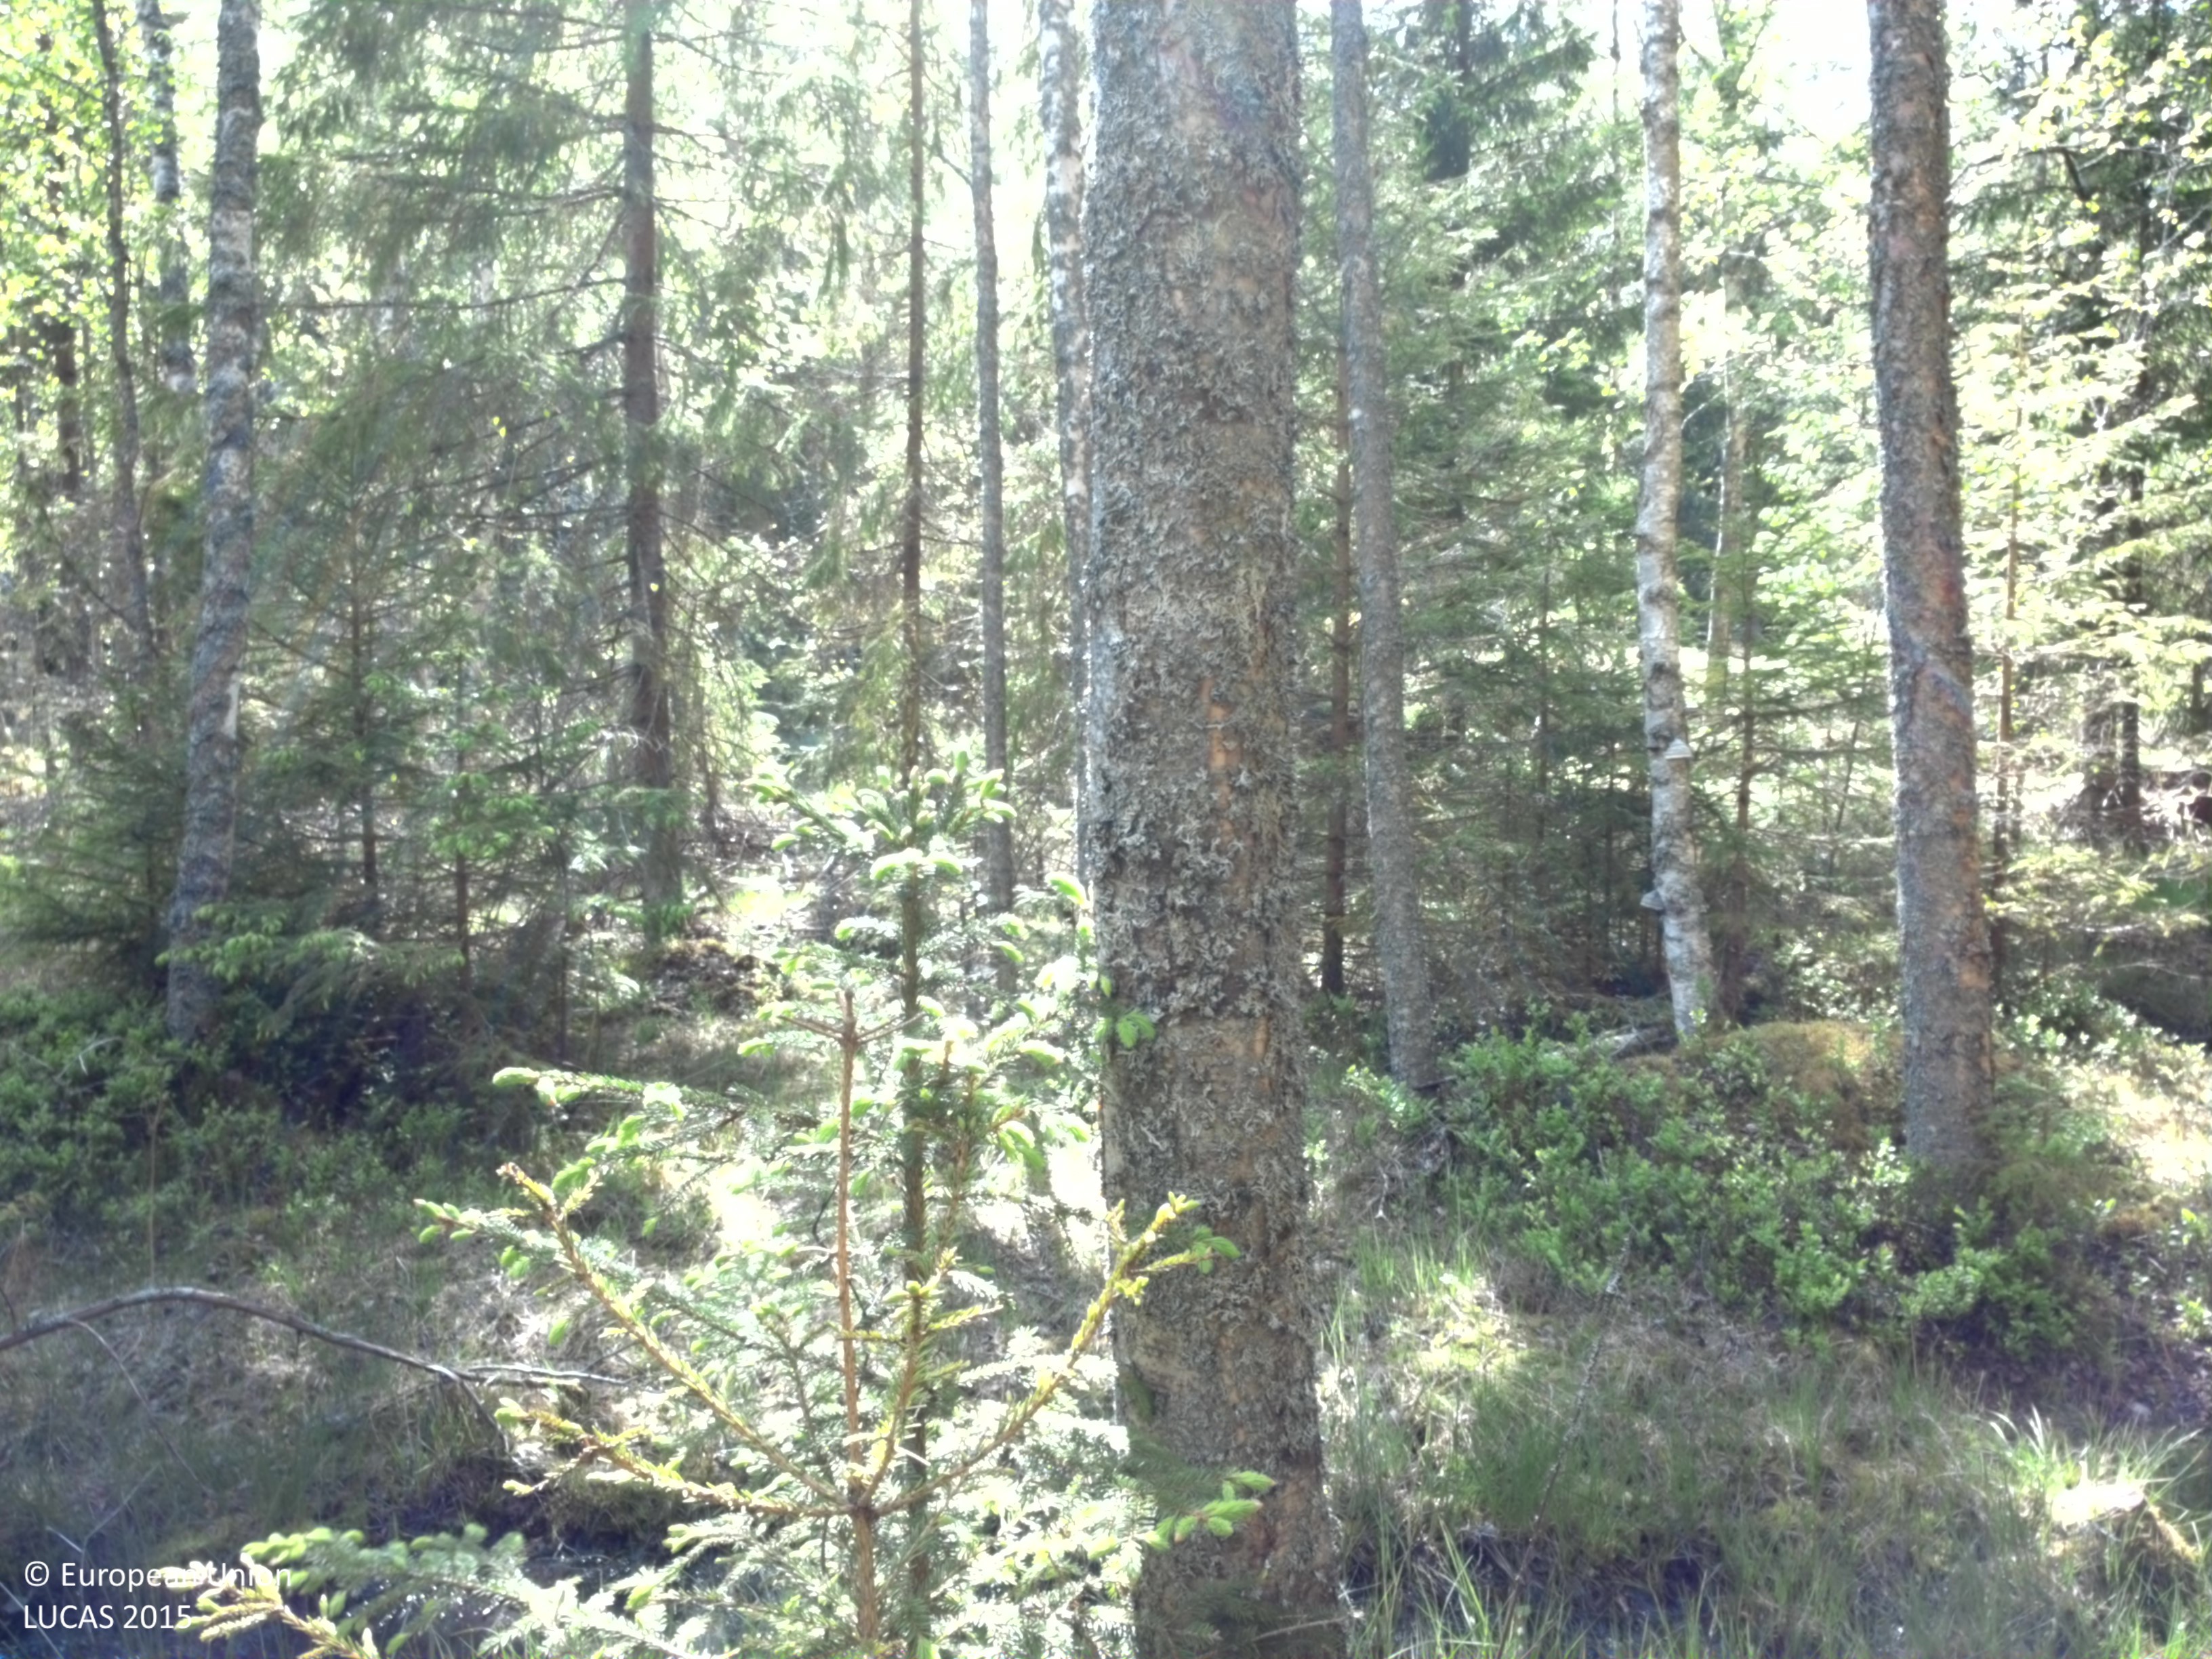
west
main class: Woodland
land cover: Spruce dominated mixed woodland
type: boreal forest
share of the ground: 50 - 75 %
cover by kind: broadleaved forest trees 35 %, herbaceous plants 25 %, lichens and mosses 20 %, coniferous forest trees 15 %, shrubs 5 %
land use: Forestry
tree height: > 5 m
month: May
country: SE
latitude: 57.3476
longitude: 15.9640
